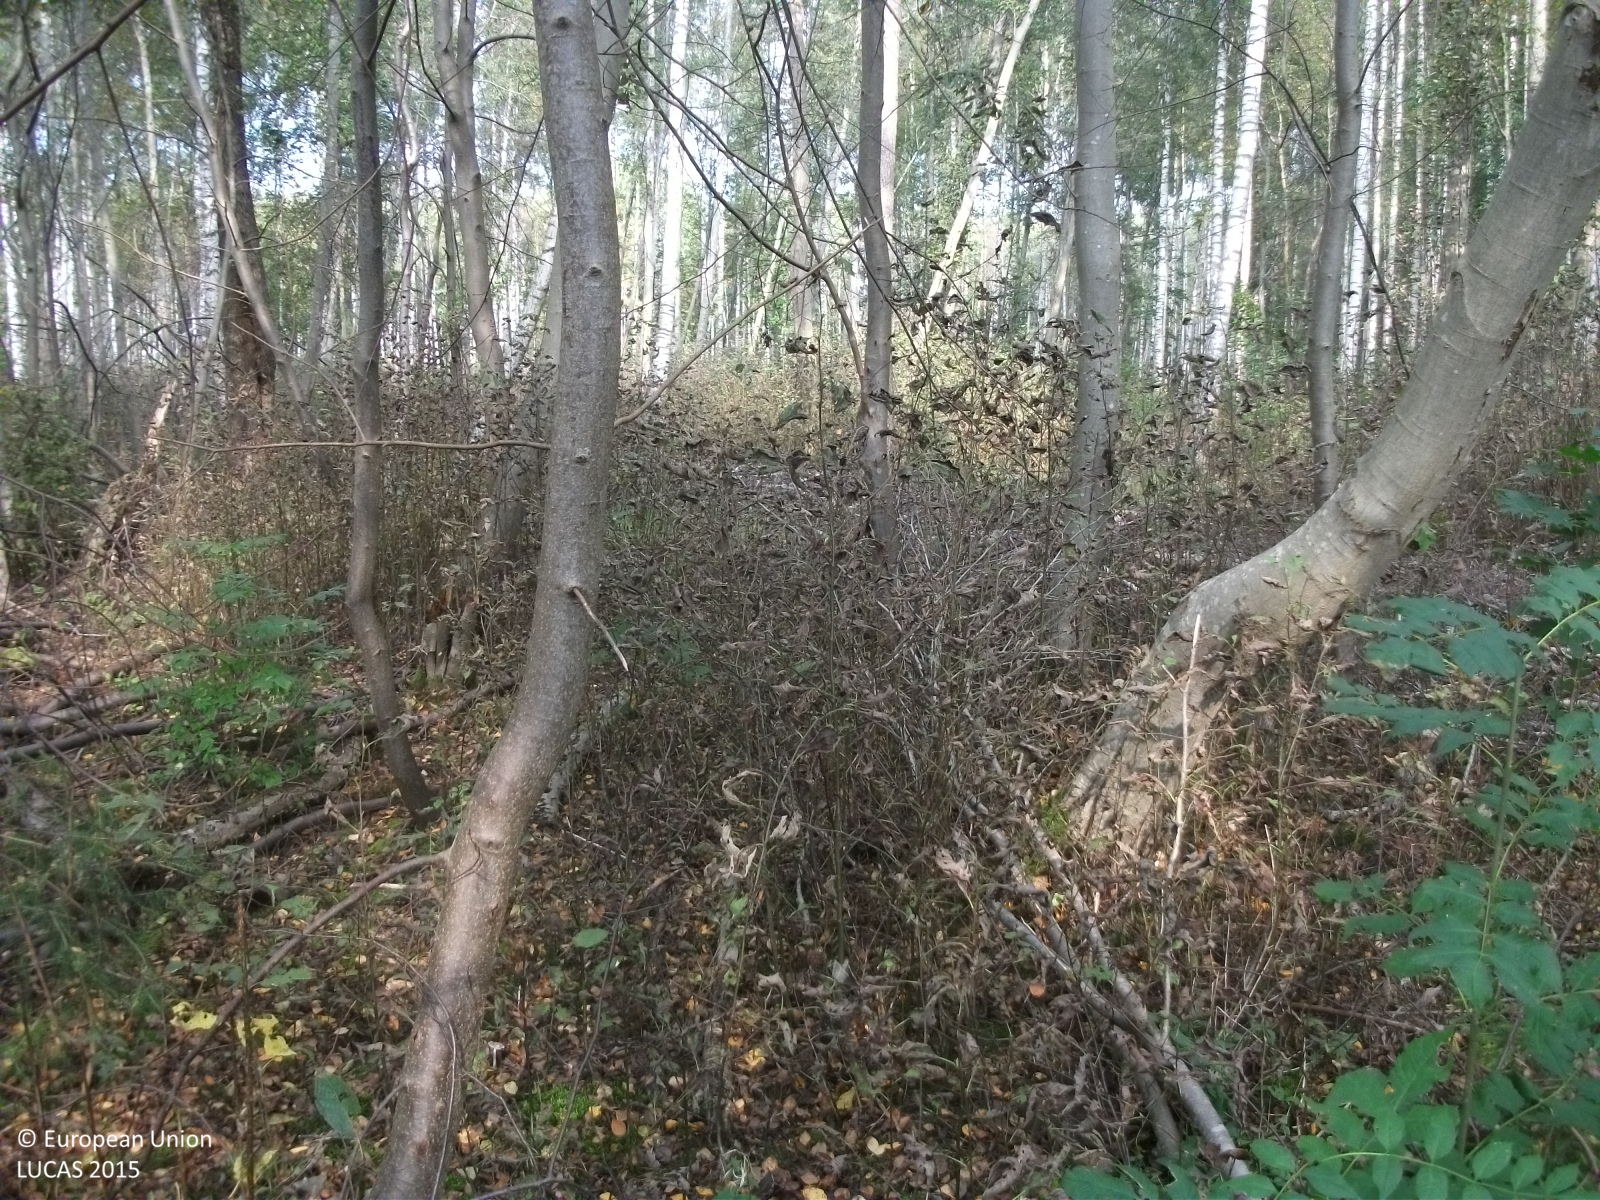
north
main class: Woodland
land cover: Broadleaved woodland
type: non-riverine alder, birch or aspen forest
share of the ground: > 75 %
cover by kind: broadleaved forest trees 80 %, herbaceous plants 10 %, shrubs 5 %
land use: Forestry
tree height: > 5 m
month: September
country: LV
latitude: 57.7965
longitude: 24.4732
